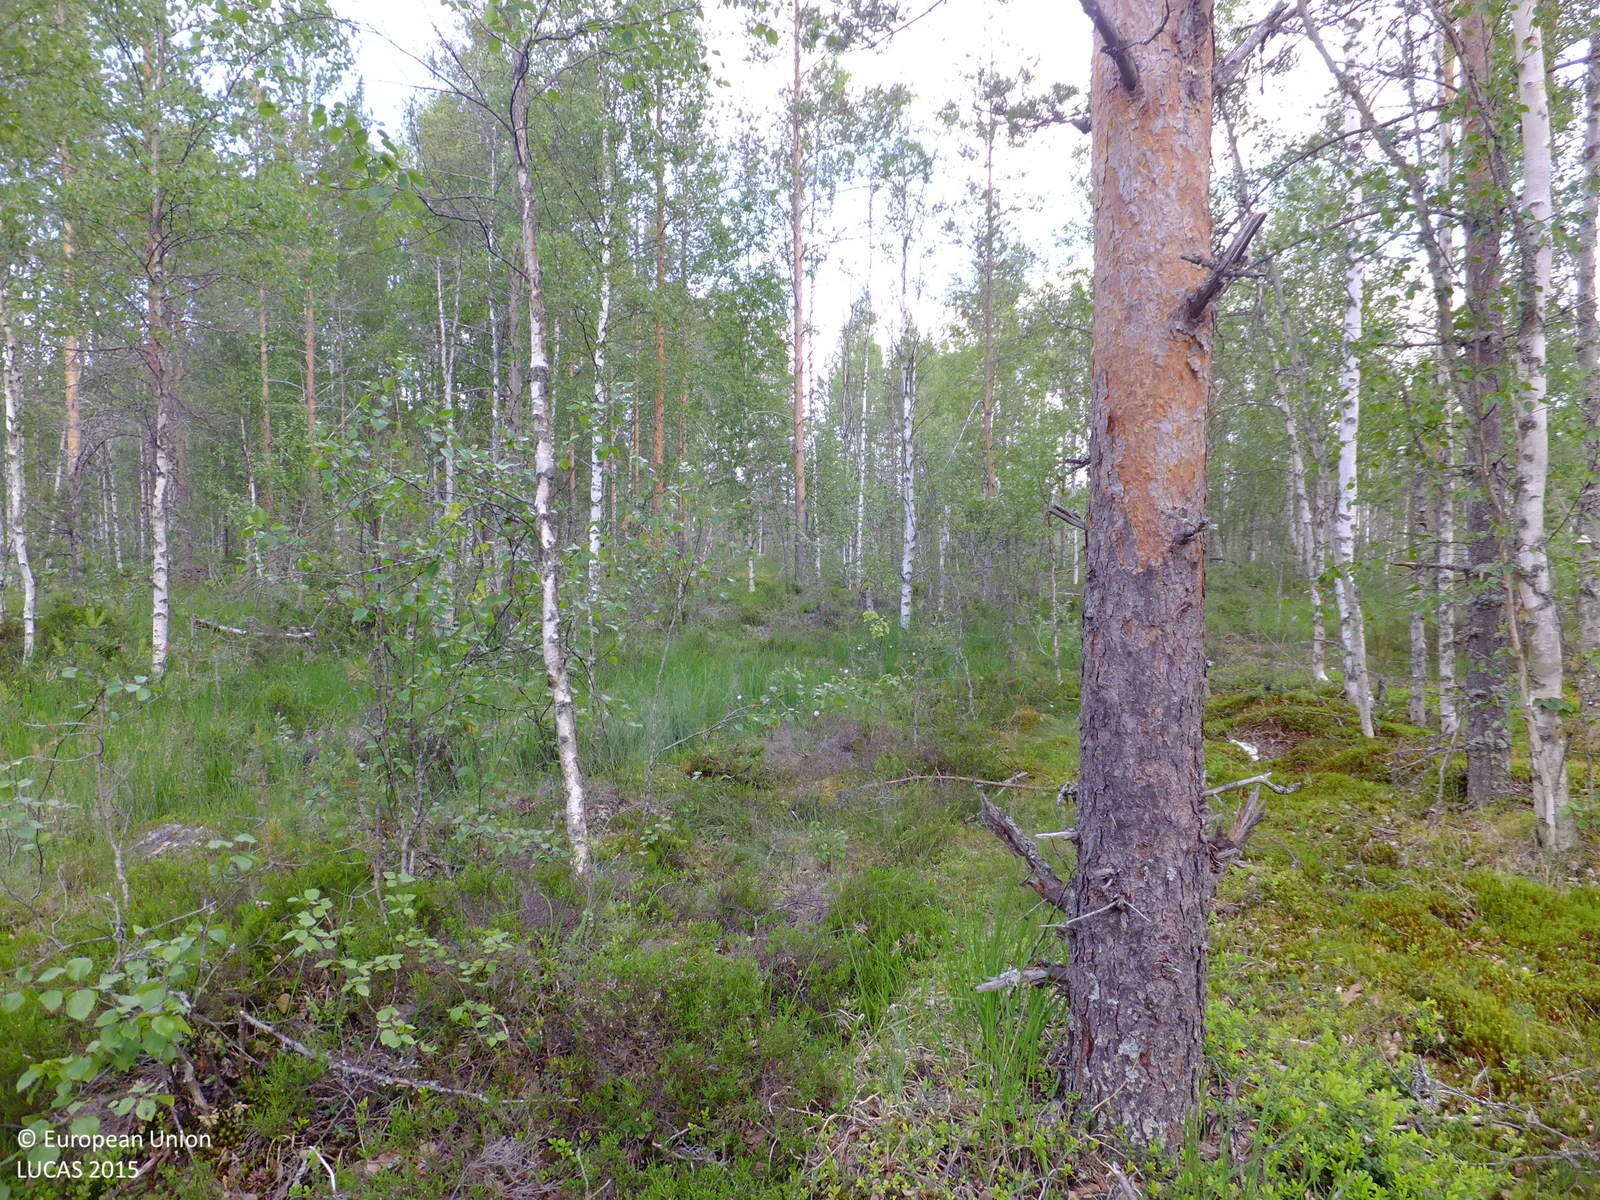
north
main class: Woodland
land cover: Pine dominated mixed woodland
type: boreal forest
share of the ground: 25 - 50 %
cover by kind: lichens and mosses 35 %, shrubs 20 %, herbaceous plants 20 %, broadleaved forest trees 15 %, coniferous forest trees 10 %
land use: Forestry
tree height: > 5 m
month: July
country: FI
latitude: 63.3706
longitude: 24.3770
